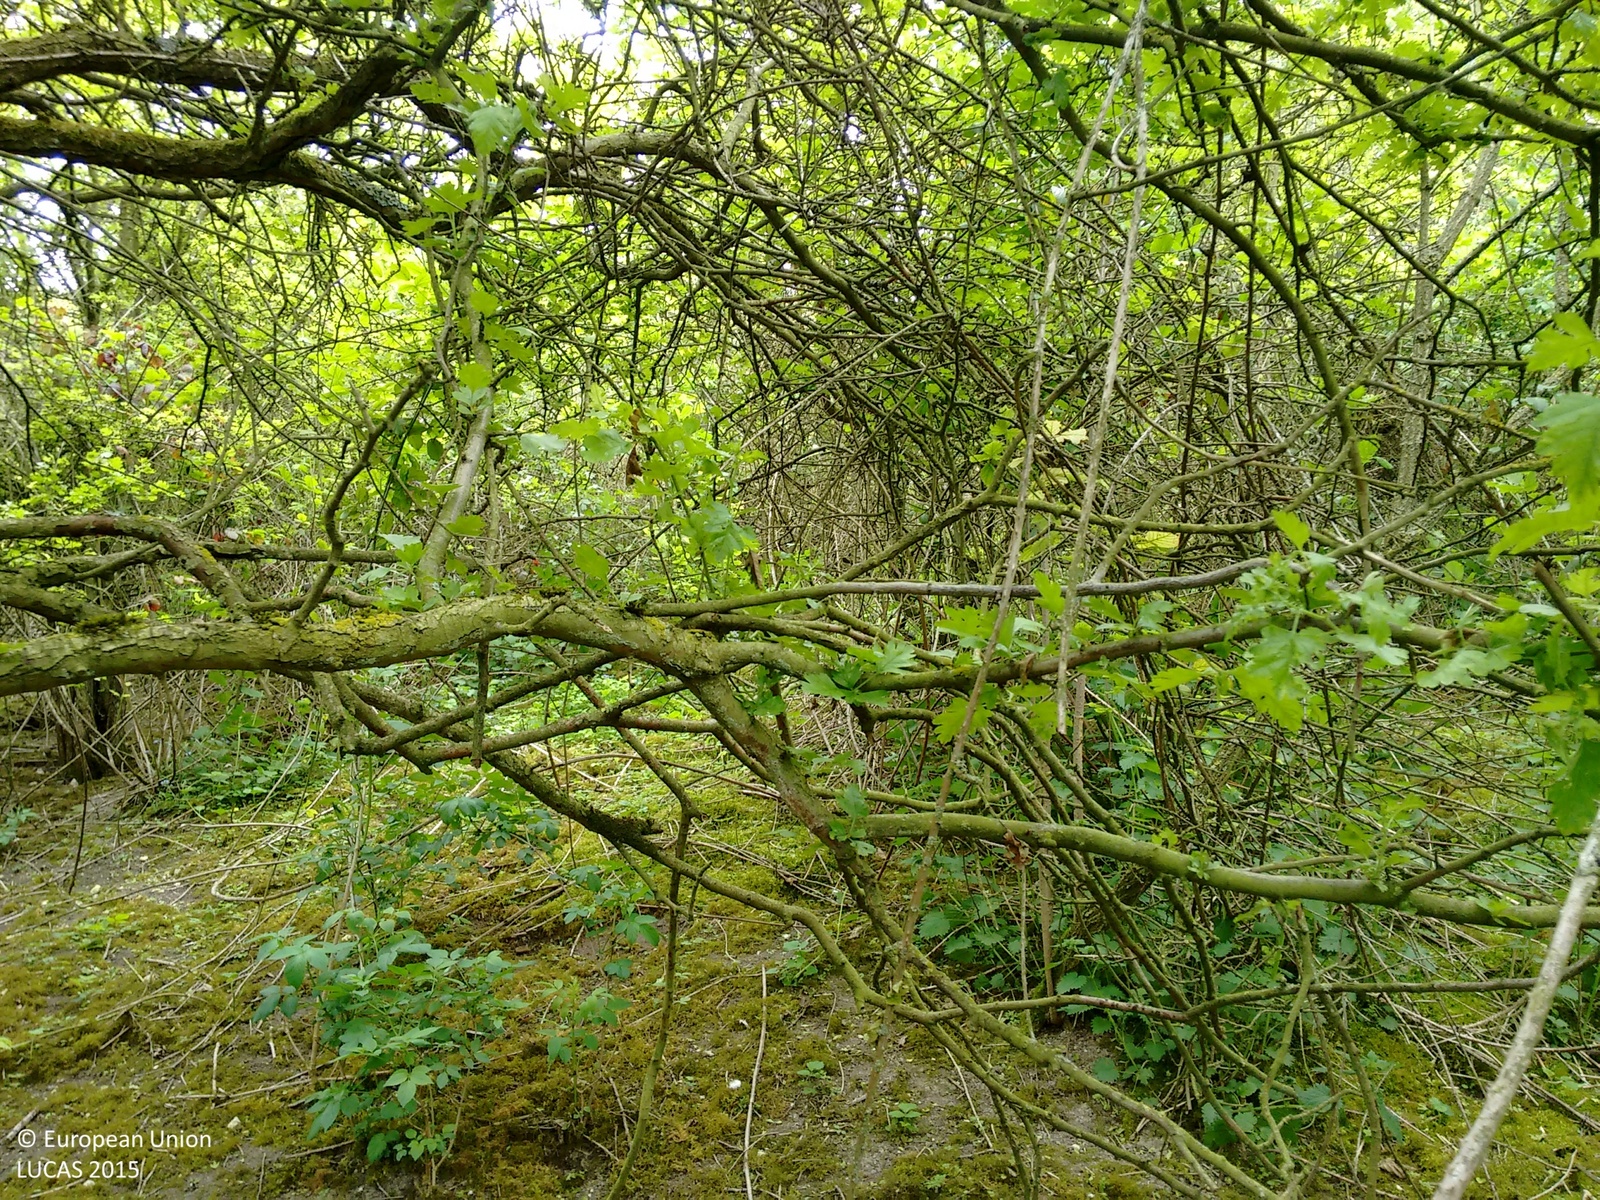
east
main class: Woodland
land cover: Broadleaved woodland
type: mesophytic deciduous forest
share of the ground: > 75 %
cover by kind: broadleaved forest trees 100 %
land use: Semi-natural and natural areas not in use
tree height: > 5 m
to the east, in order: Broadleaved woodland; Grassland with sparse tree/shrub cover; Fences; Grassland without tree/shrub cover; Tracks; Grassland with sparse tree/shrub cover; Managed hedges; Grass margins; Paved roads, cycling and walking lanes; Grass margins; Abandoned hedges; Broadleaved woodland; Grassland without tree/shrub cover
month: May
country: GB
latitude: 51.8706
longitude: -0.5396
